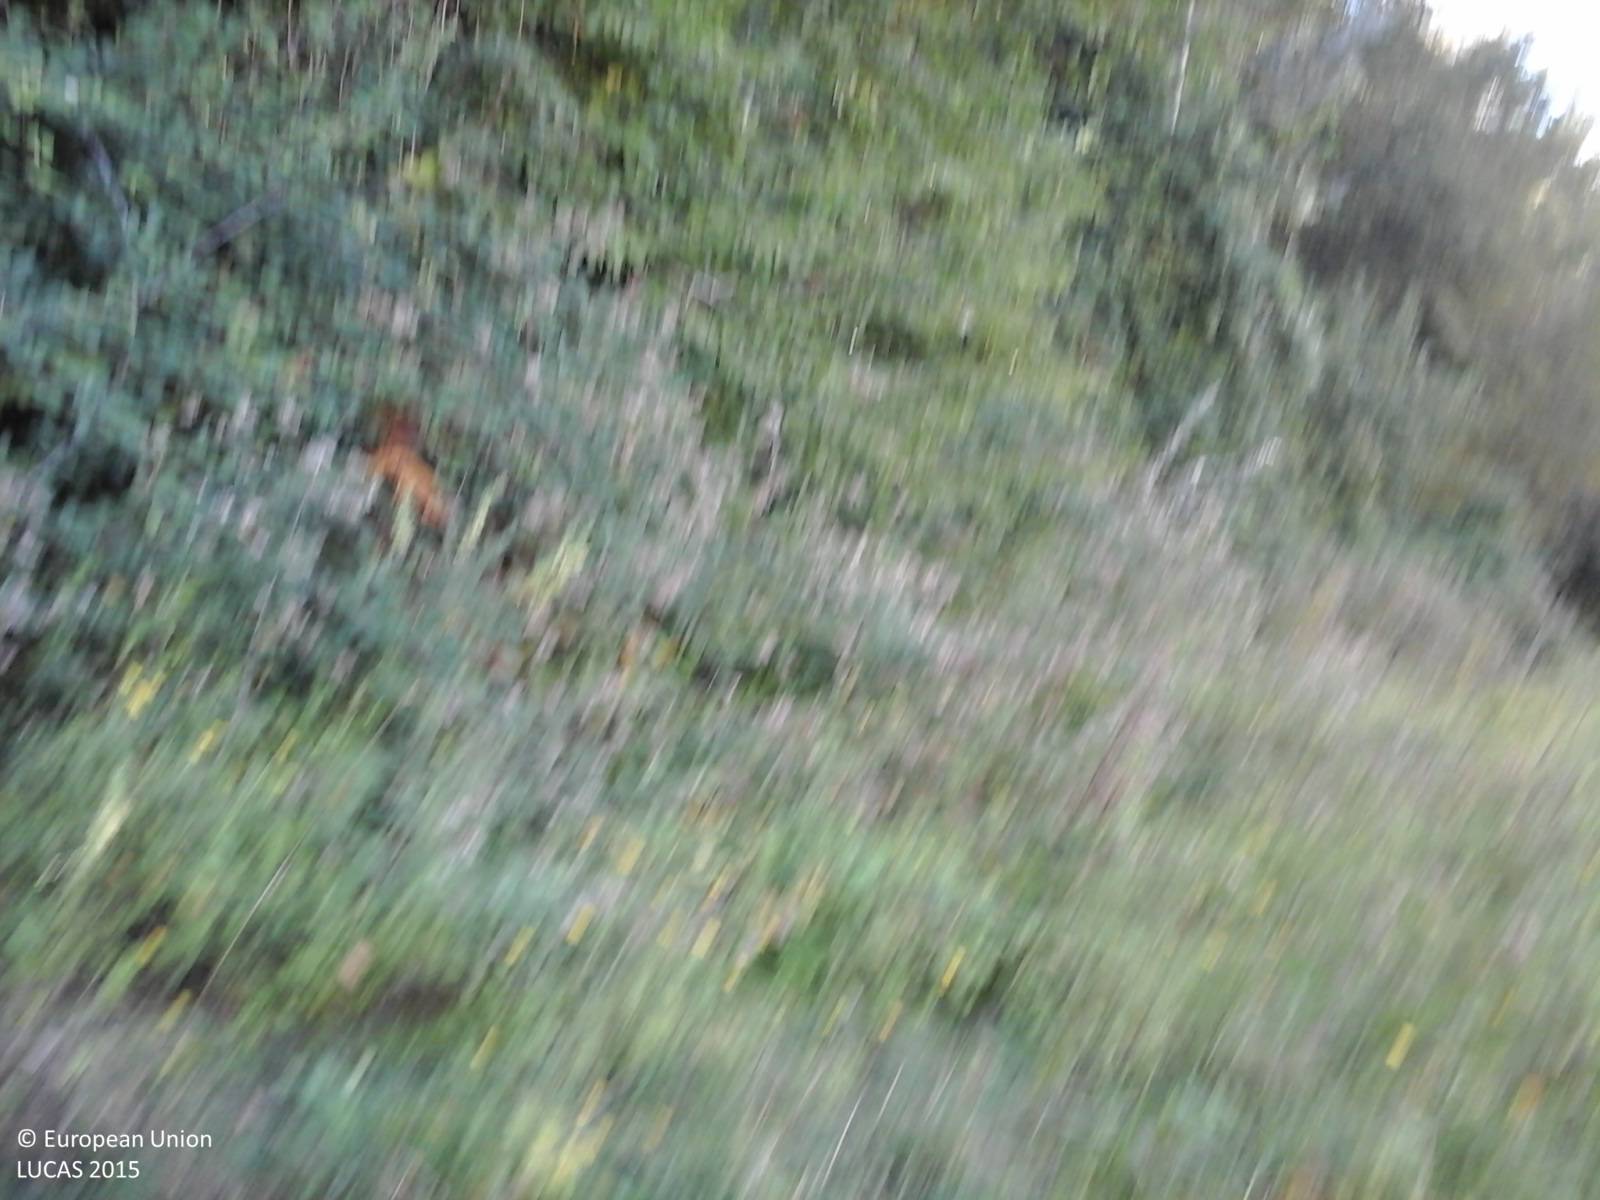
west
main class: Woodland
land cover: Broadleaved woodland
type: thermophilous deciduous forest
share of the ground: > 75 %
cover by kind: broadleaved forest trees 100 %
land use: Semi-natural and natural areas not in use
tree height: > 5 m
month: September
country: IT
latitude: 42.3502
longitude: 12.5770
